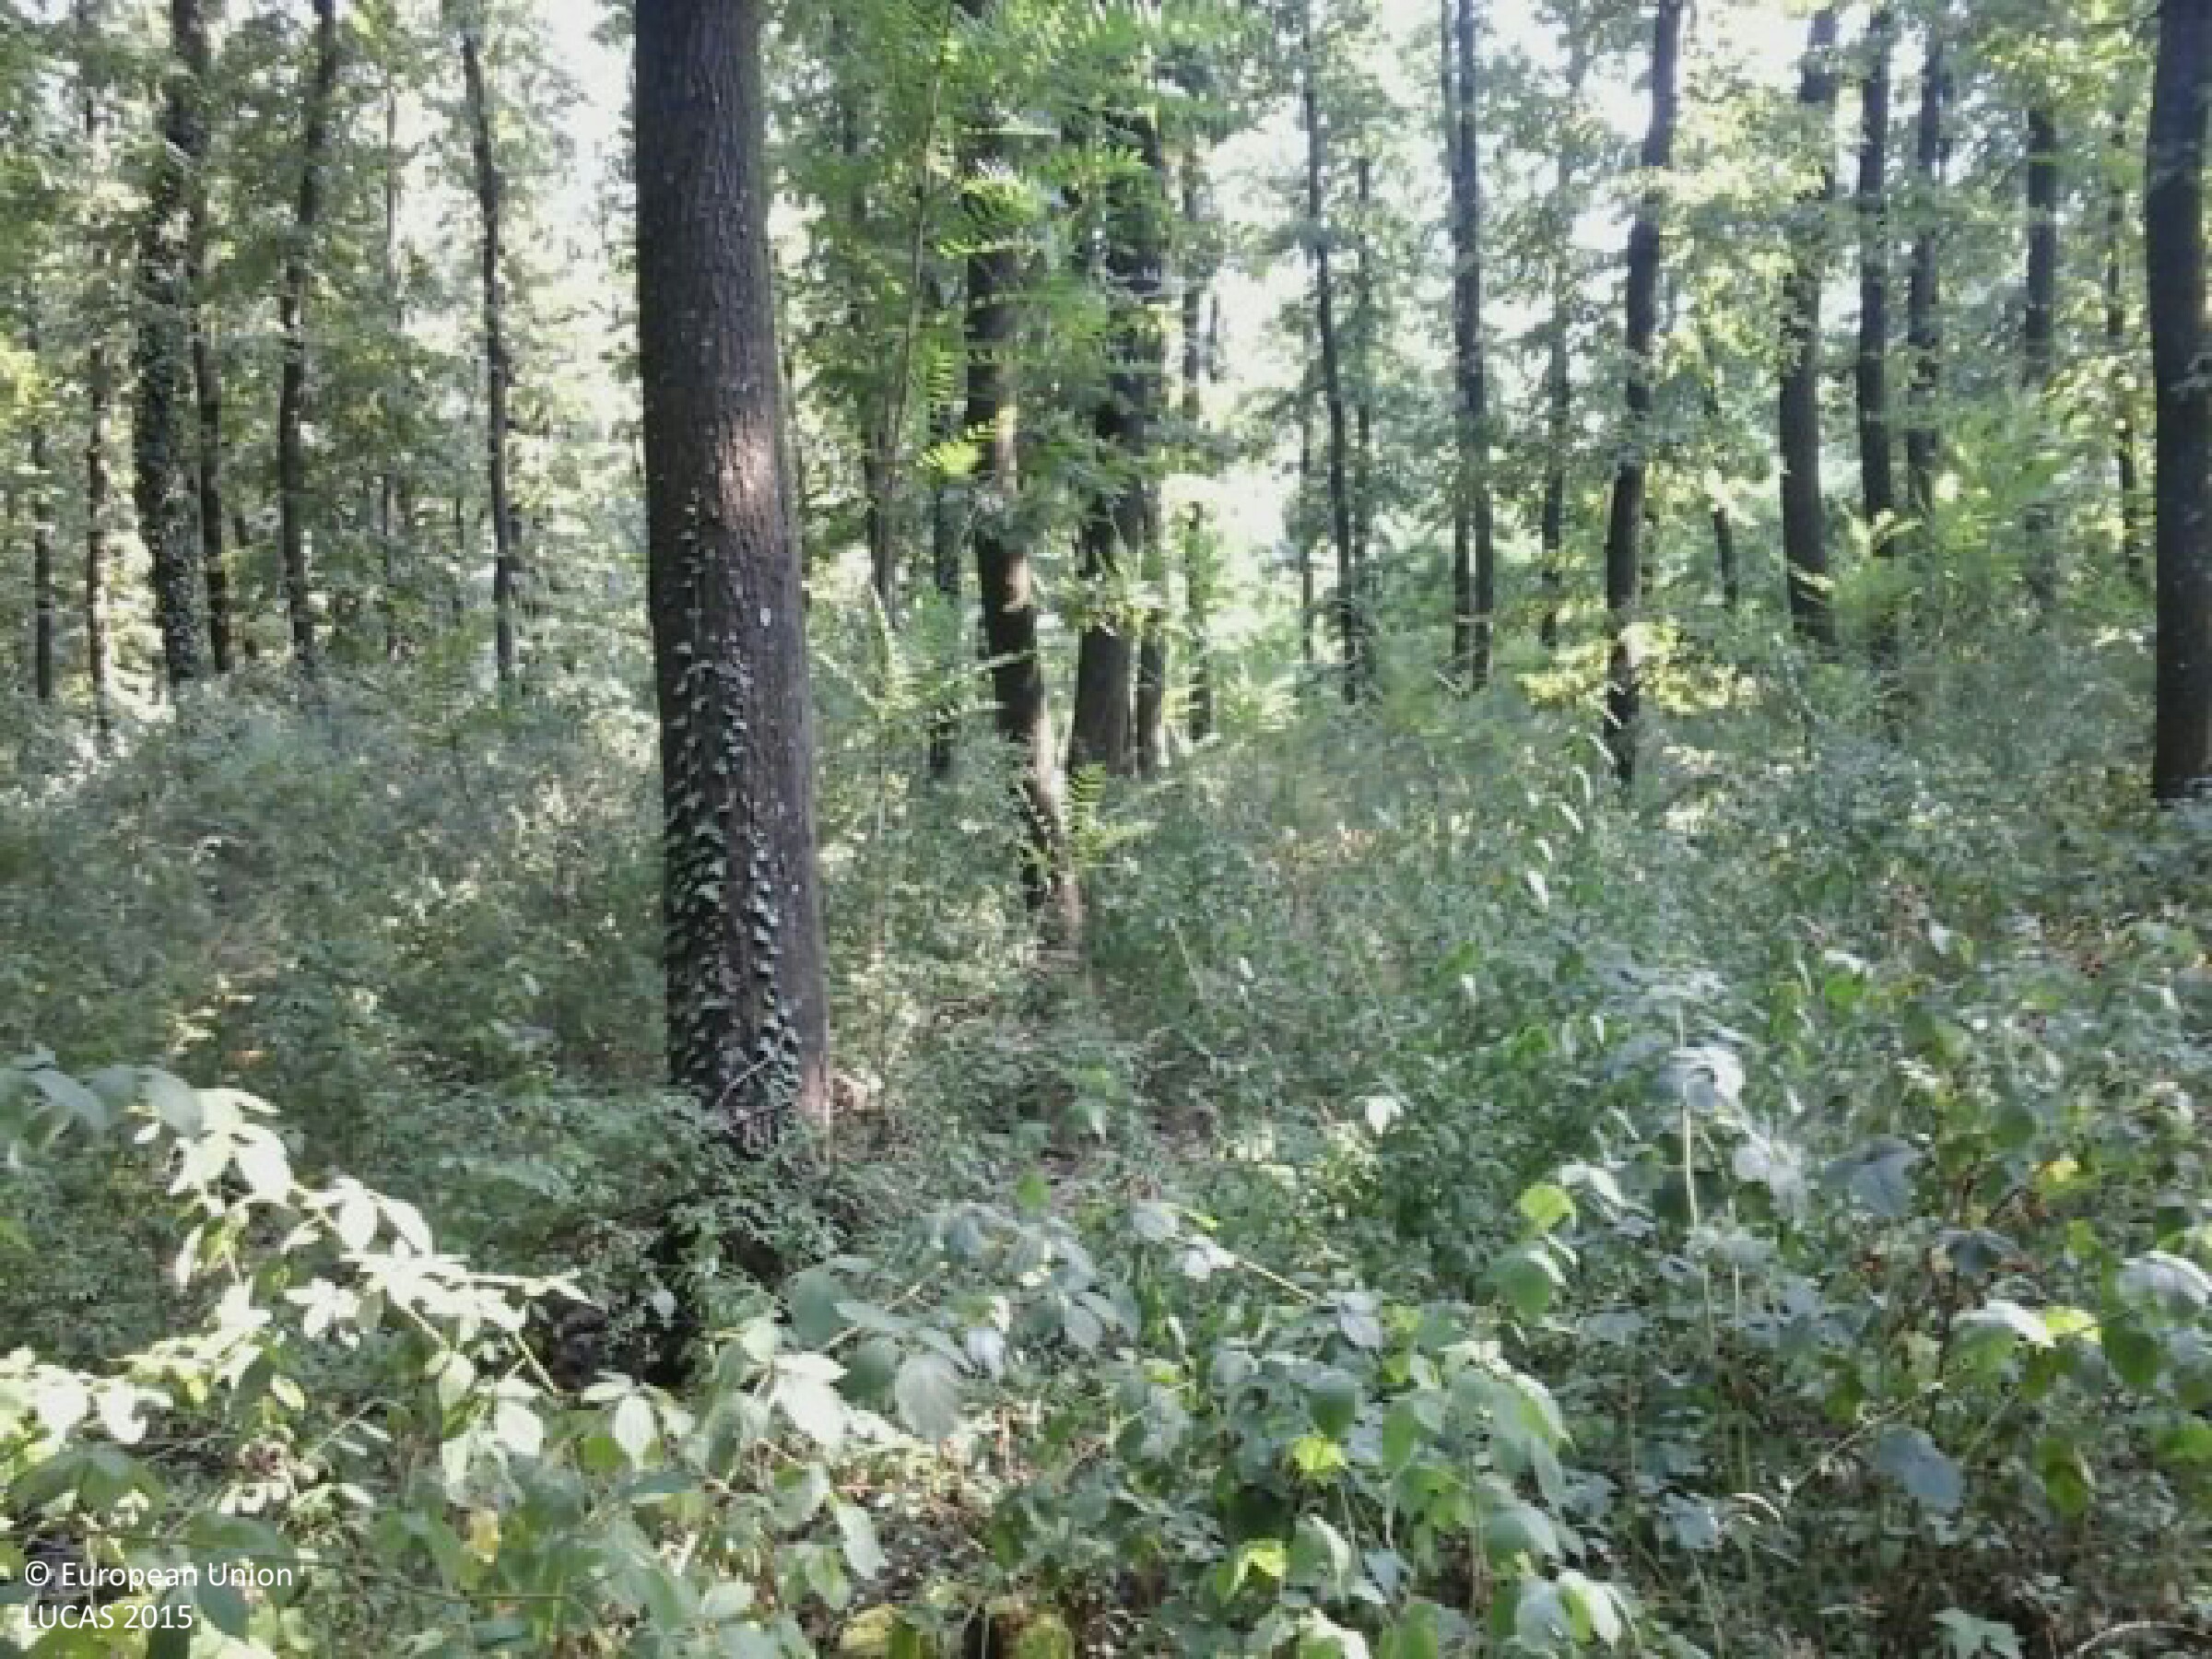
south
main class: Woodland
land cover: Broadleaved woodland
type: mesophytic deciduous forest
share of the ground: > 75 %
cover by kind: broadleaved forest trees 90 %, shrubs 5 %, herbaceous plants 5 %
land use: Forestry
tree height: > 5 m
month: August
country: HU
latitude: 46.5596
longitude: 17.9777
